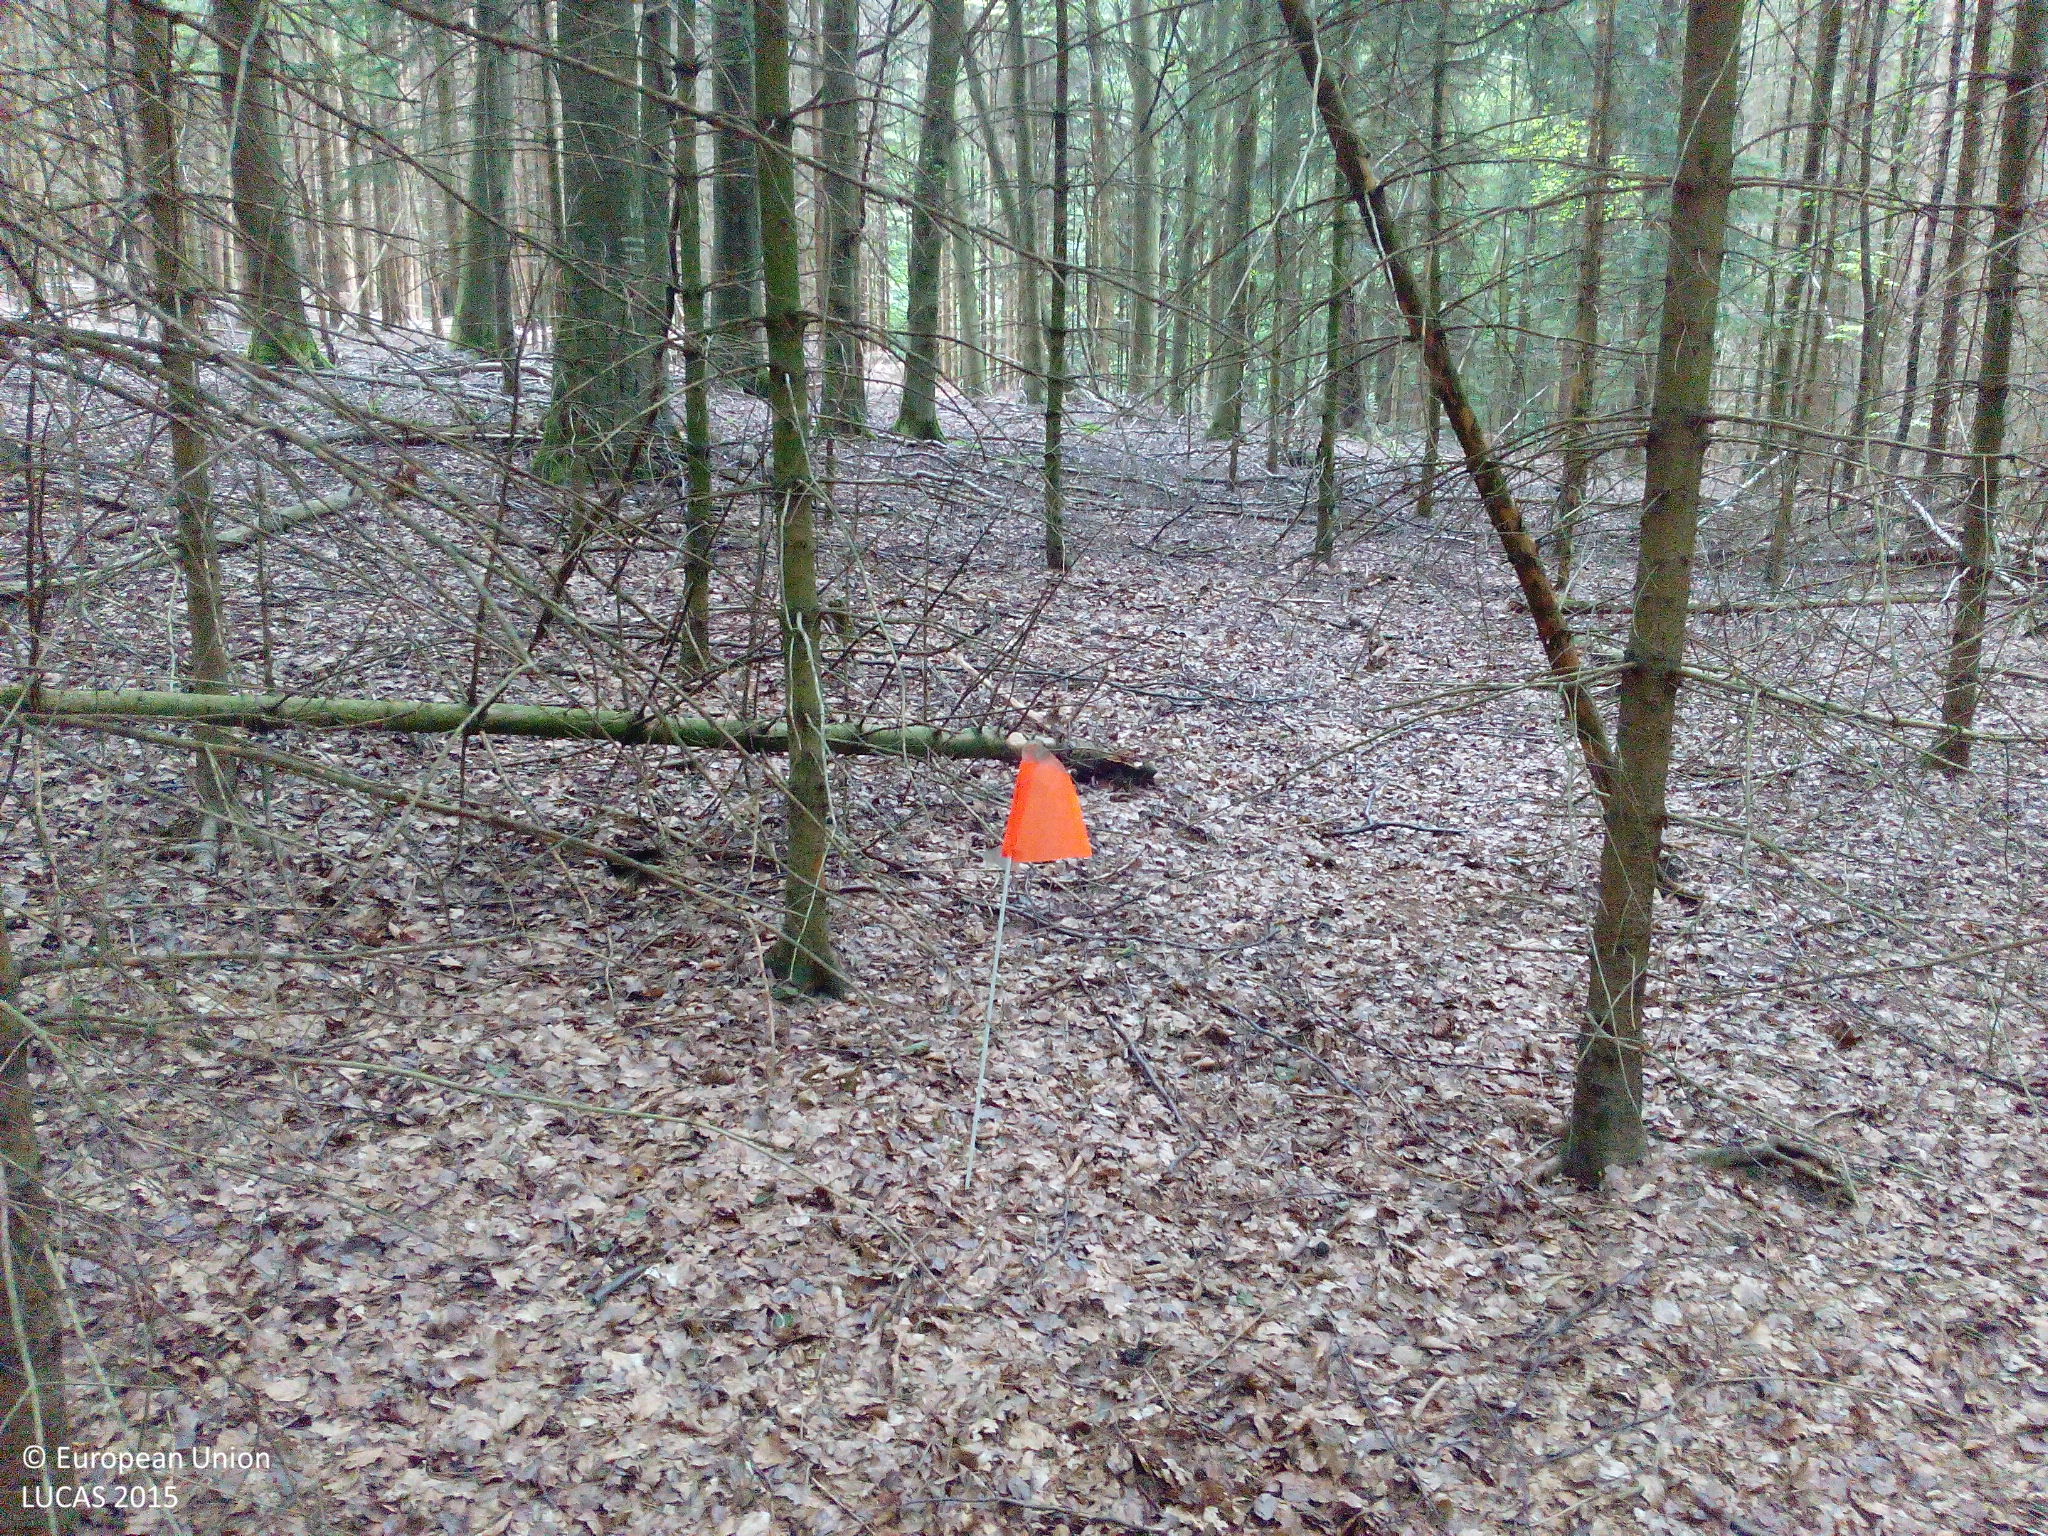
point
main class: Woodland
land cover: Spruce dominated mixed woodland
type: hemiboreal forest and nemoral coniferous forest and mixed broadleaved-coniferous forest
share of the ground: > 75 %
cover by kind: coniferous forest trees 70 %, broadleaved forest trees 30 %
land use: Forestry
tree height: > 5 m
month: July
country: DE
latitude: 50.5438
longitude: 9.9295
